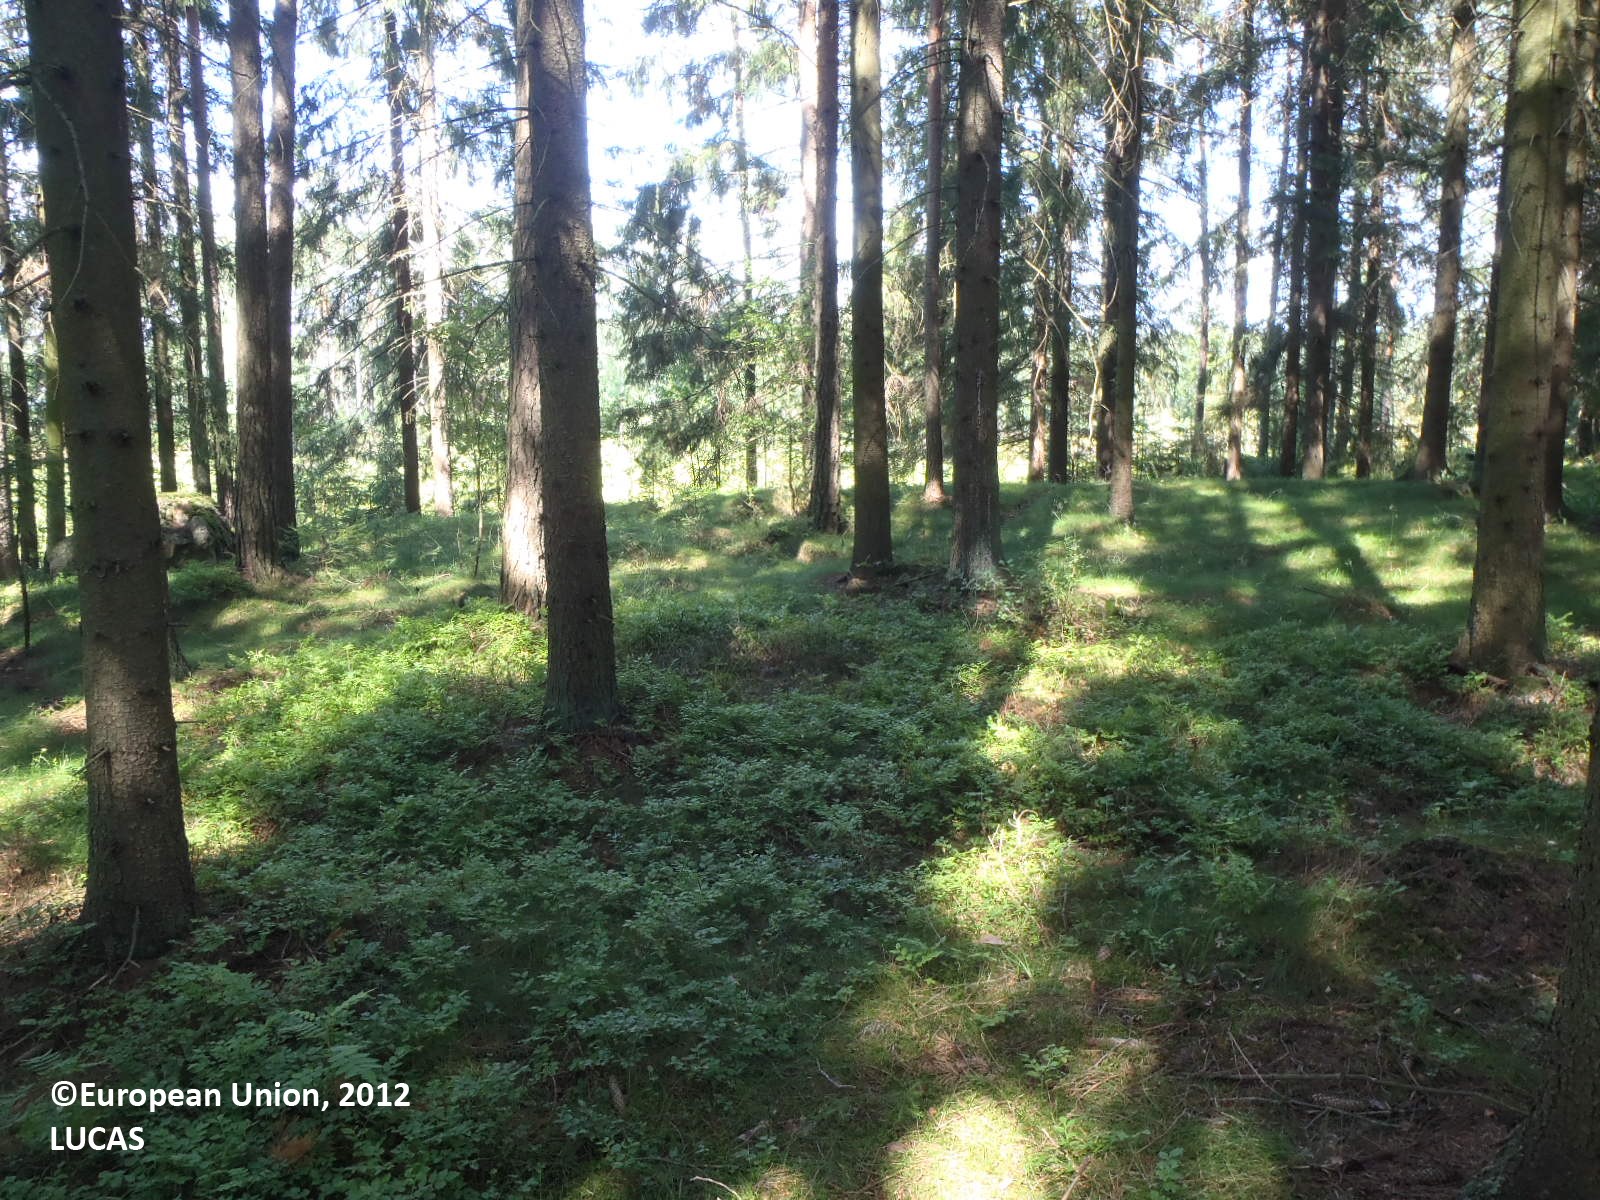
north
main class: Woodland
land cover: Other coniferous woodland
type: boreal forest
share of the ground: > 75 %
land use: Forestry
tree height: > 5 m
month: July
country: FI
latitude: 60.7103
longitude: 21.7309
